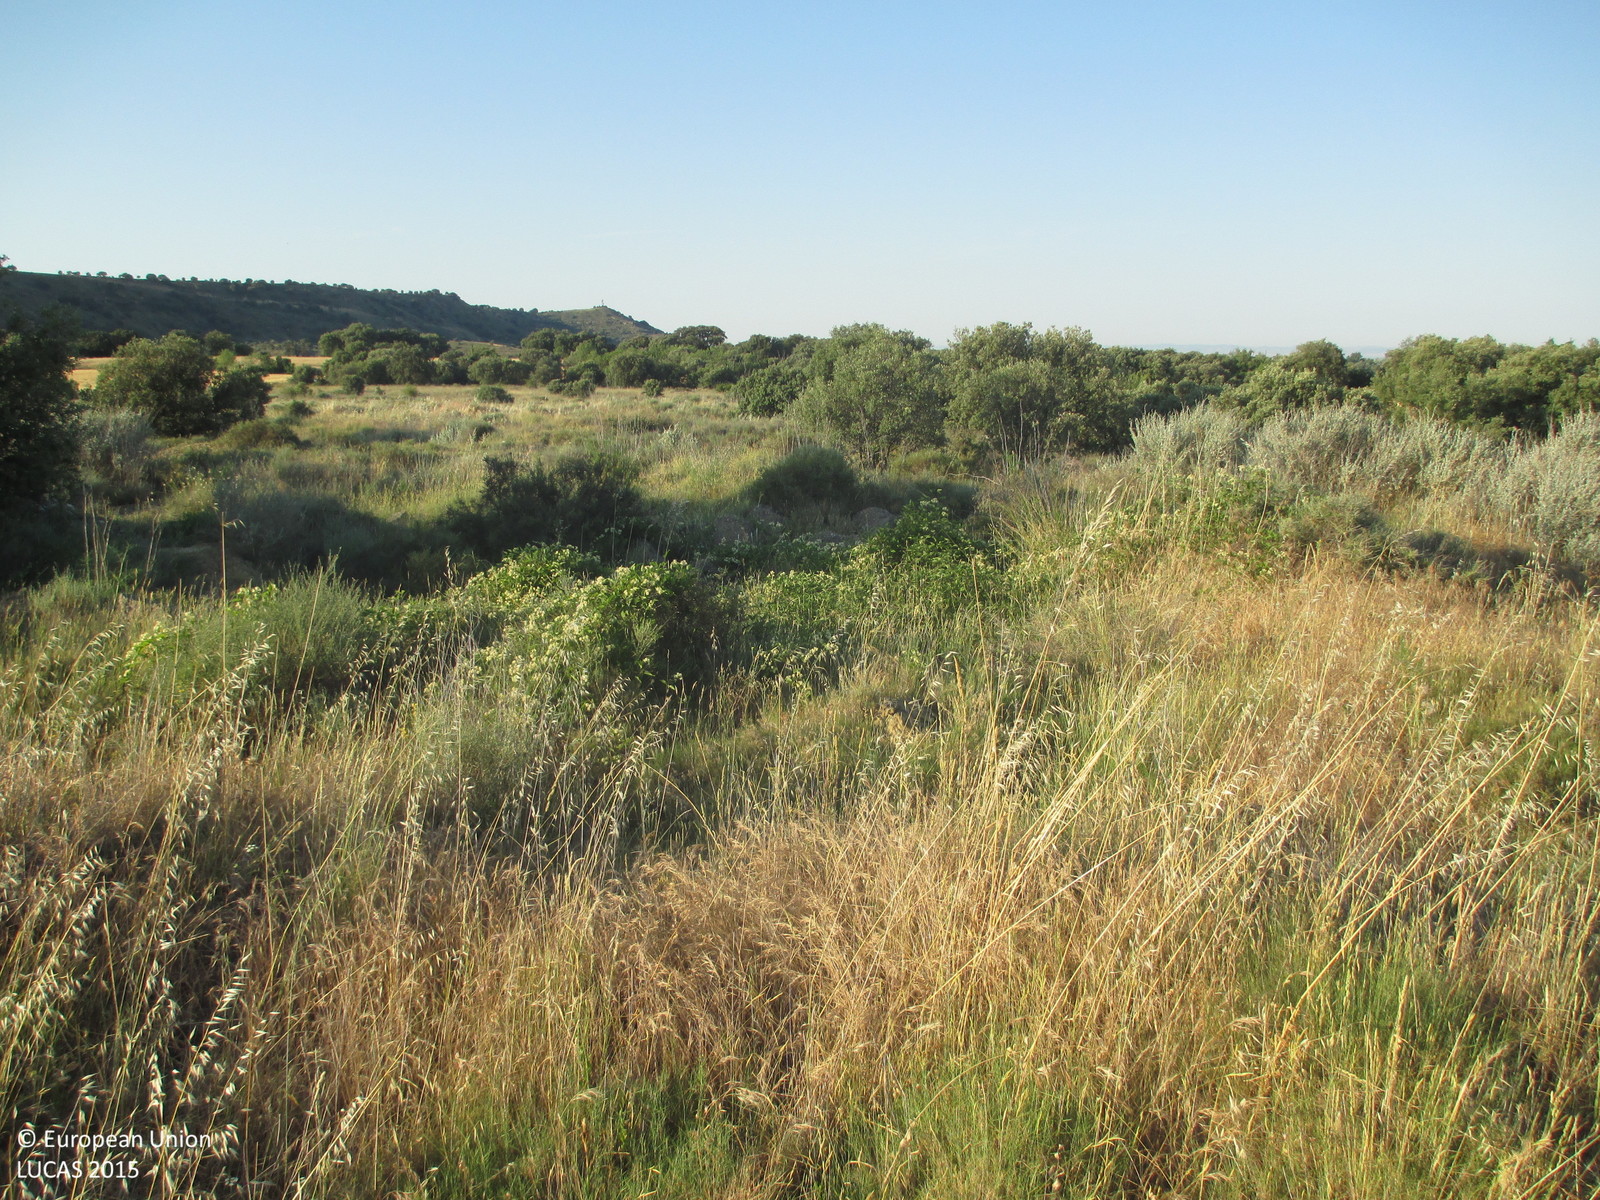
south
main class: Grassland
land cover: Grassland with sparse tree/shrub cover
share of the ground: > 75 %
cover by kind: herbaceous plants 90 %, broadleaved forest trees 5 %, shrubs 5 %
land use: Semi-natural and natural areas not in use
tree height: < 5 m
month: June
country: ES
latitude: 42.1413
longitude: -0.3431
